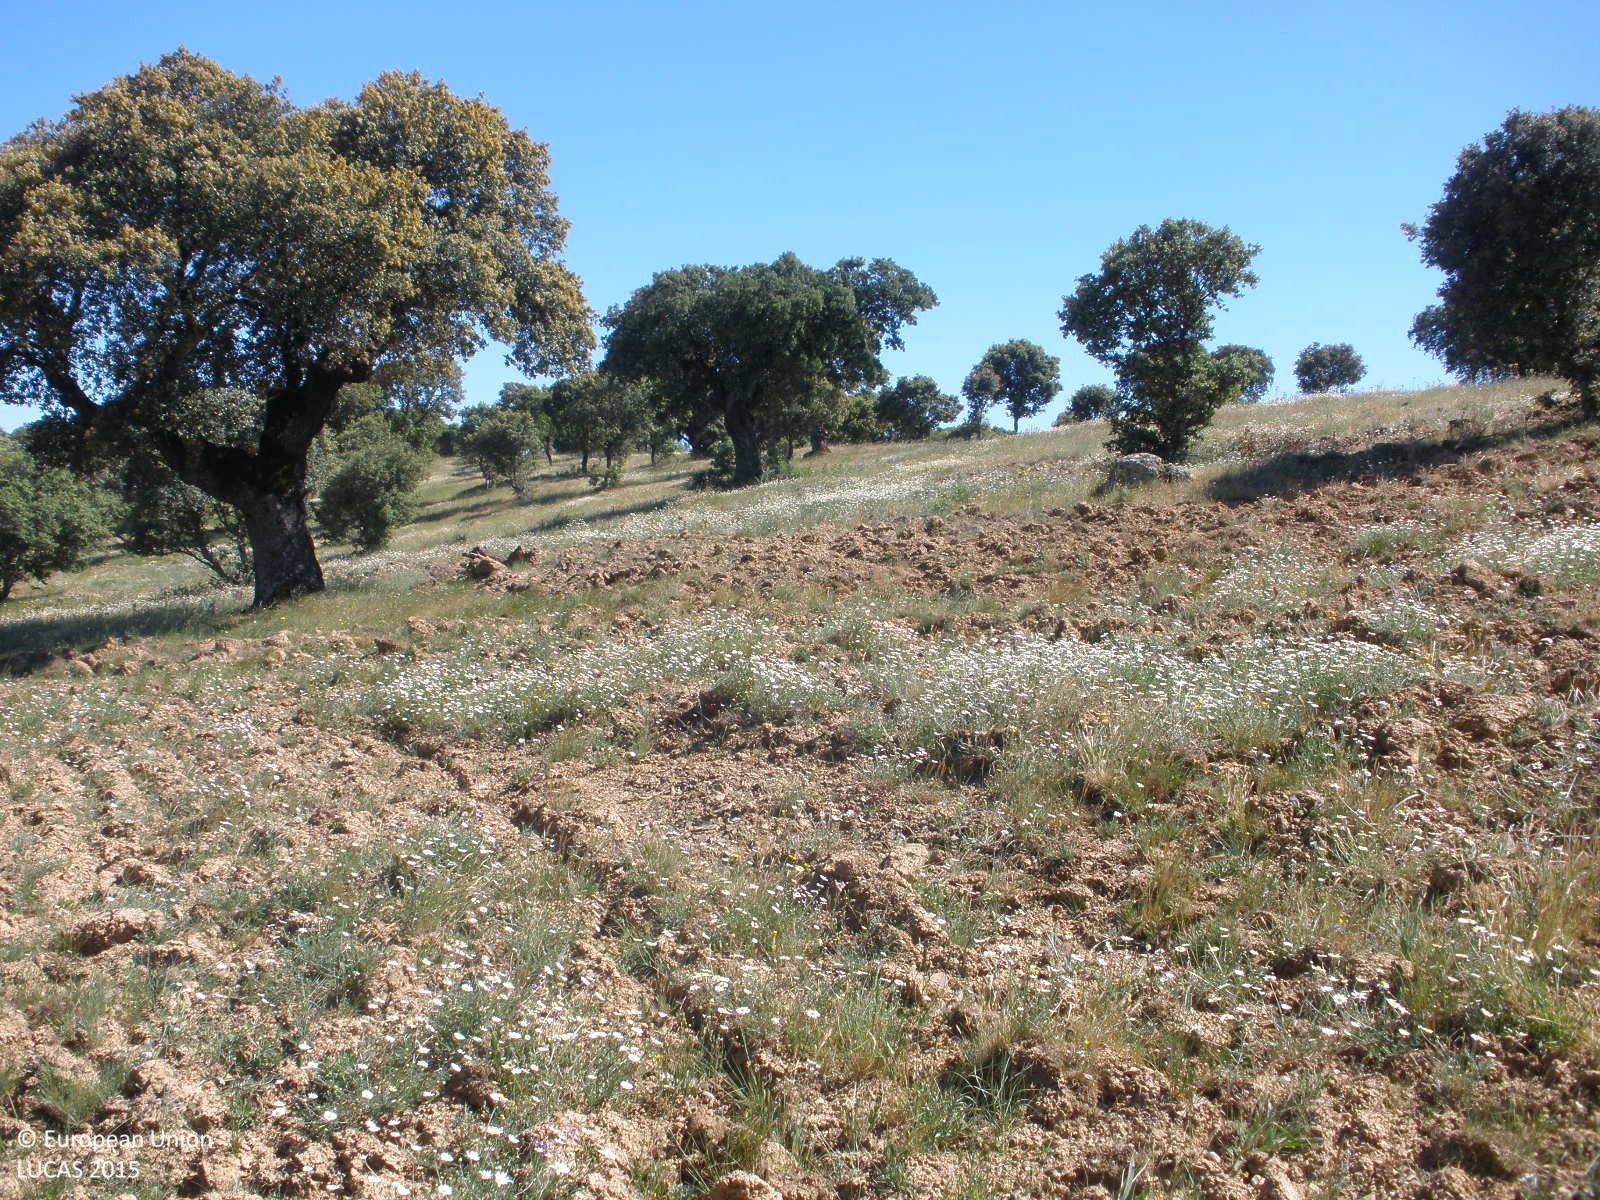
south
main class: Woodland
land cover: Broadleaved woodland
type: broadleaved evergreen forest
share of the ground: 25 - 50 %
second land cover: Grassland without tree/shrub cover
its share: 50 - 75 %
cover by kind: herbaceous plants 50 %, broadleaved forest trees 30 %, unconsolidated bare surface 20 %
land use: Forestry
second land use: Agriculture (excluding fallow land and kitchen gardens)
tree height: < 5 m
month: May
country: ES
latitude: 40.6980
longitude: -5.8526
